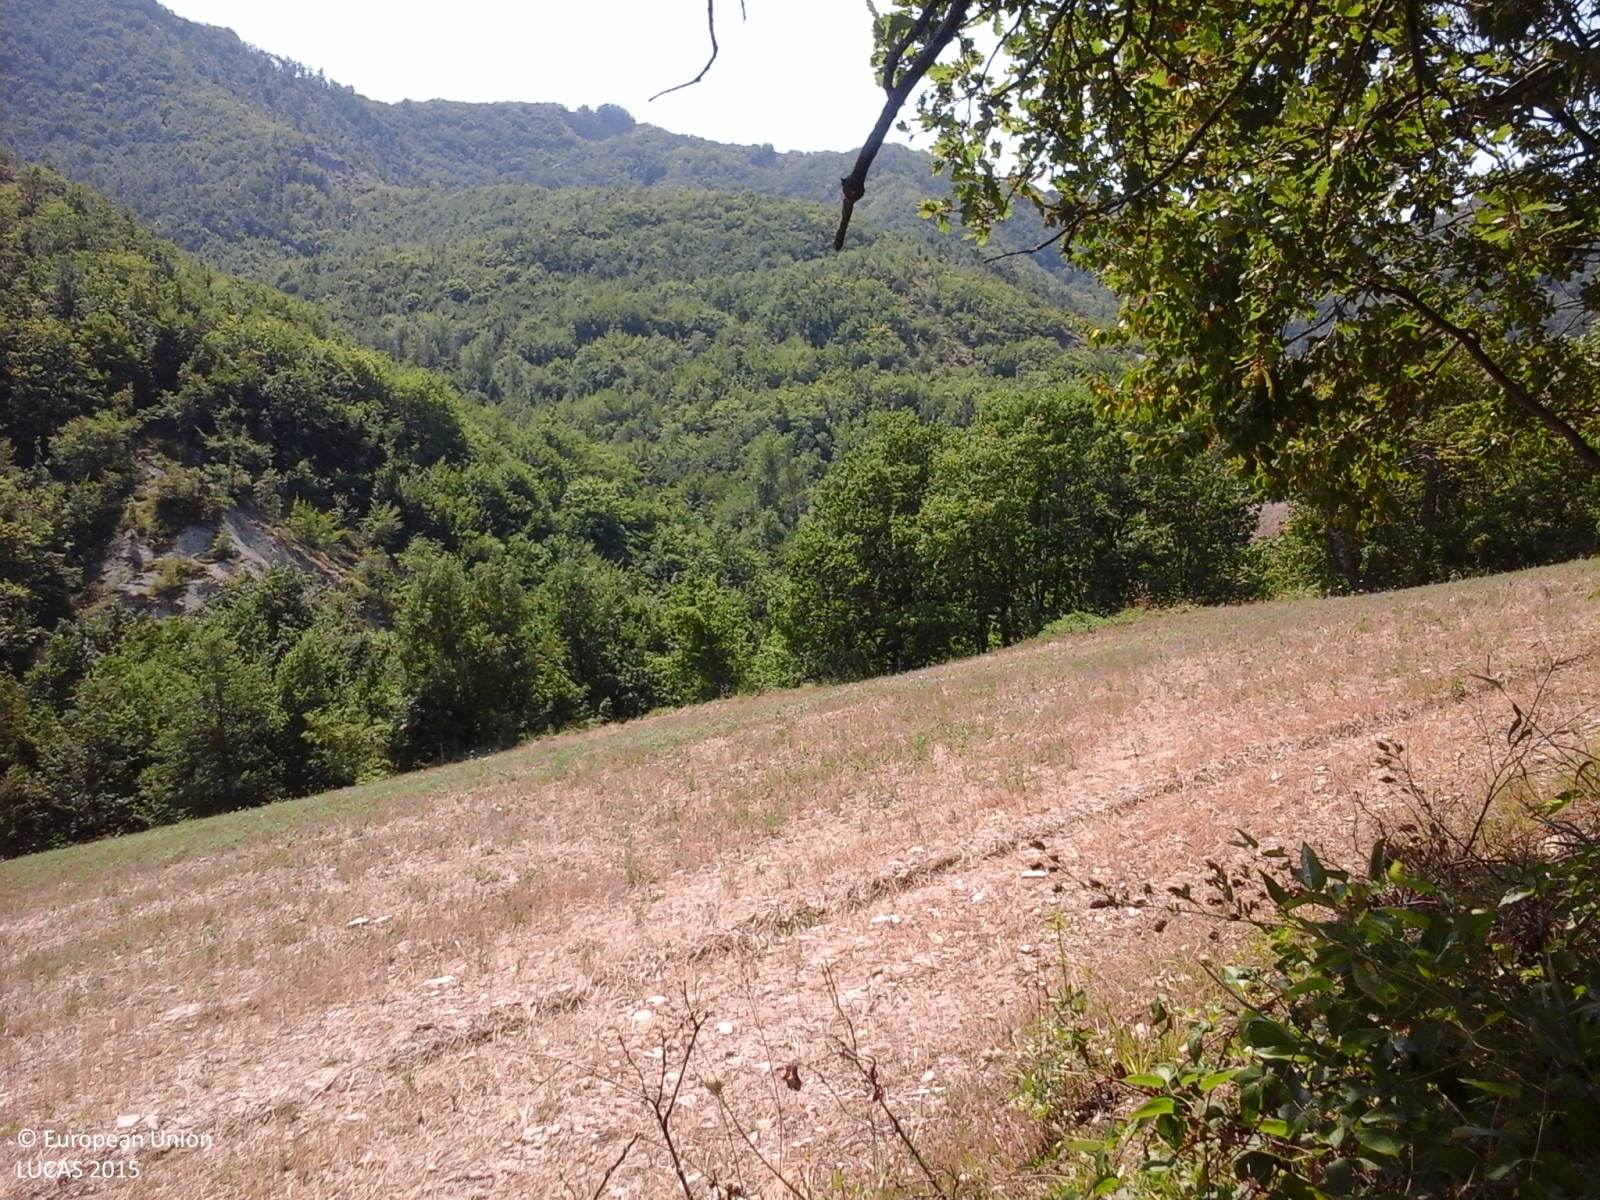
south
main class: Woodland
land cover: Broadleaved woodland
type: thermophilous deciduous forest
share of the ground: > 75 %
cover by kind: broadleaved forest trees 100 %
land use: Forestry
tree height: > 5 m
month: August
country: IT
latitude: 43.6942
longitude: 12.2648
